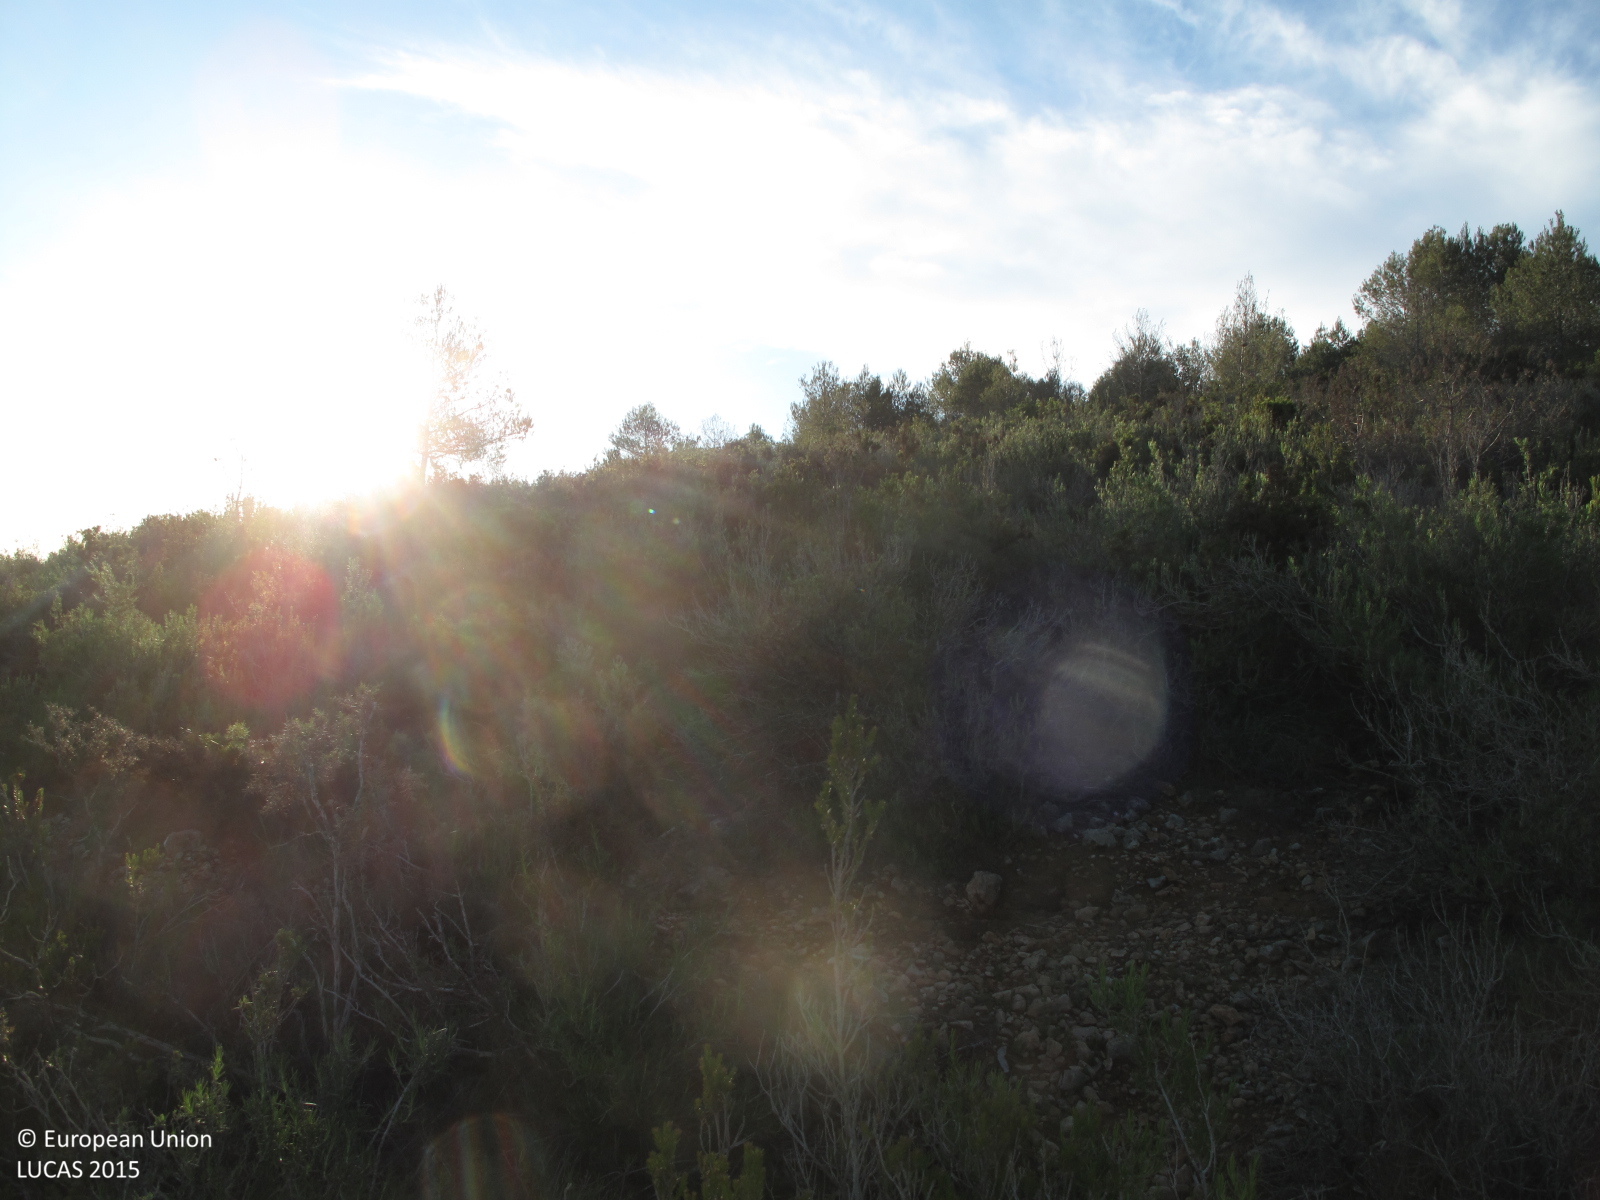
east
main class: Shrubland
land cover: Shrubland with sparse tree cover
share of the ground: > 75 %
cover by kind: shrubs 75 %, herbaceous plants 10 %, lichens and mosses 10 %, coniferous forest trees 5 %
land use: Semi-natural and natural areas not in use
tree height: > 5 m
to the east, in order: Shrubland with sparse tree cover; Paved roads, cycling and walking lanes; Pine dominated coniferous woodland; Olive groves
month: May
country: ES
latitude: 38.8234
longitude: -0.5300
